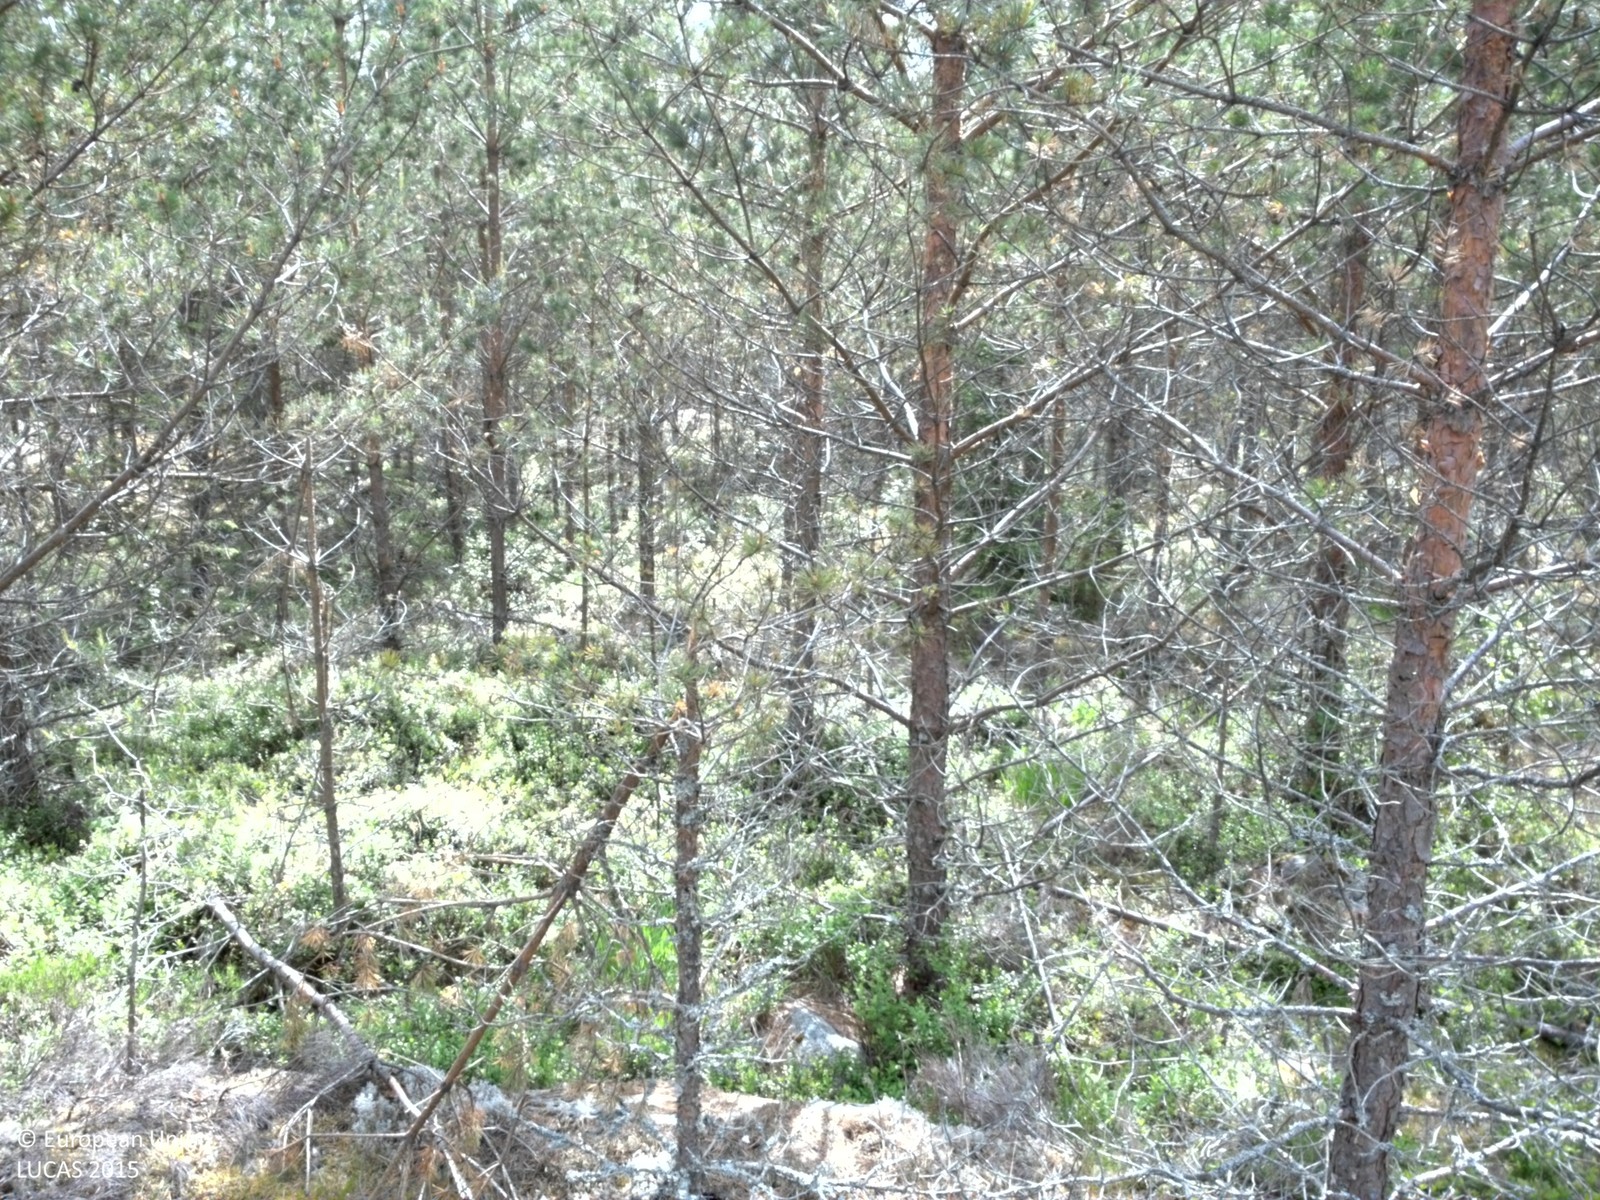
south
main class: Woodland
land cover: Pine dominated coniferous woodland
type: boreal forest
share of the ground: 25 - 50 %
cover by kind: coniferous forest trees 45 %, lichens and mosses 25 %, herbaceous plants 15 %, consolidated bare surface 10 %, broadleaved forest trees 5 %
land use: Forestry
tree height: > 5 m
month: June
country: SE
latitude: 59.9852
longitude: 17.0712
